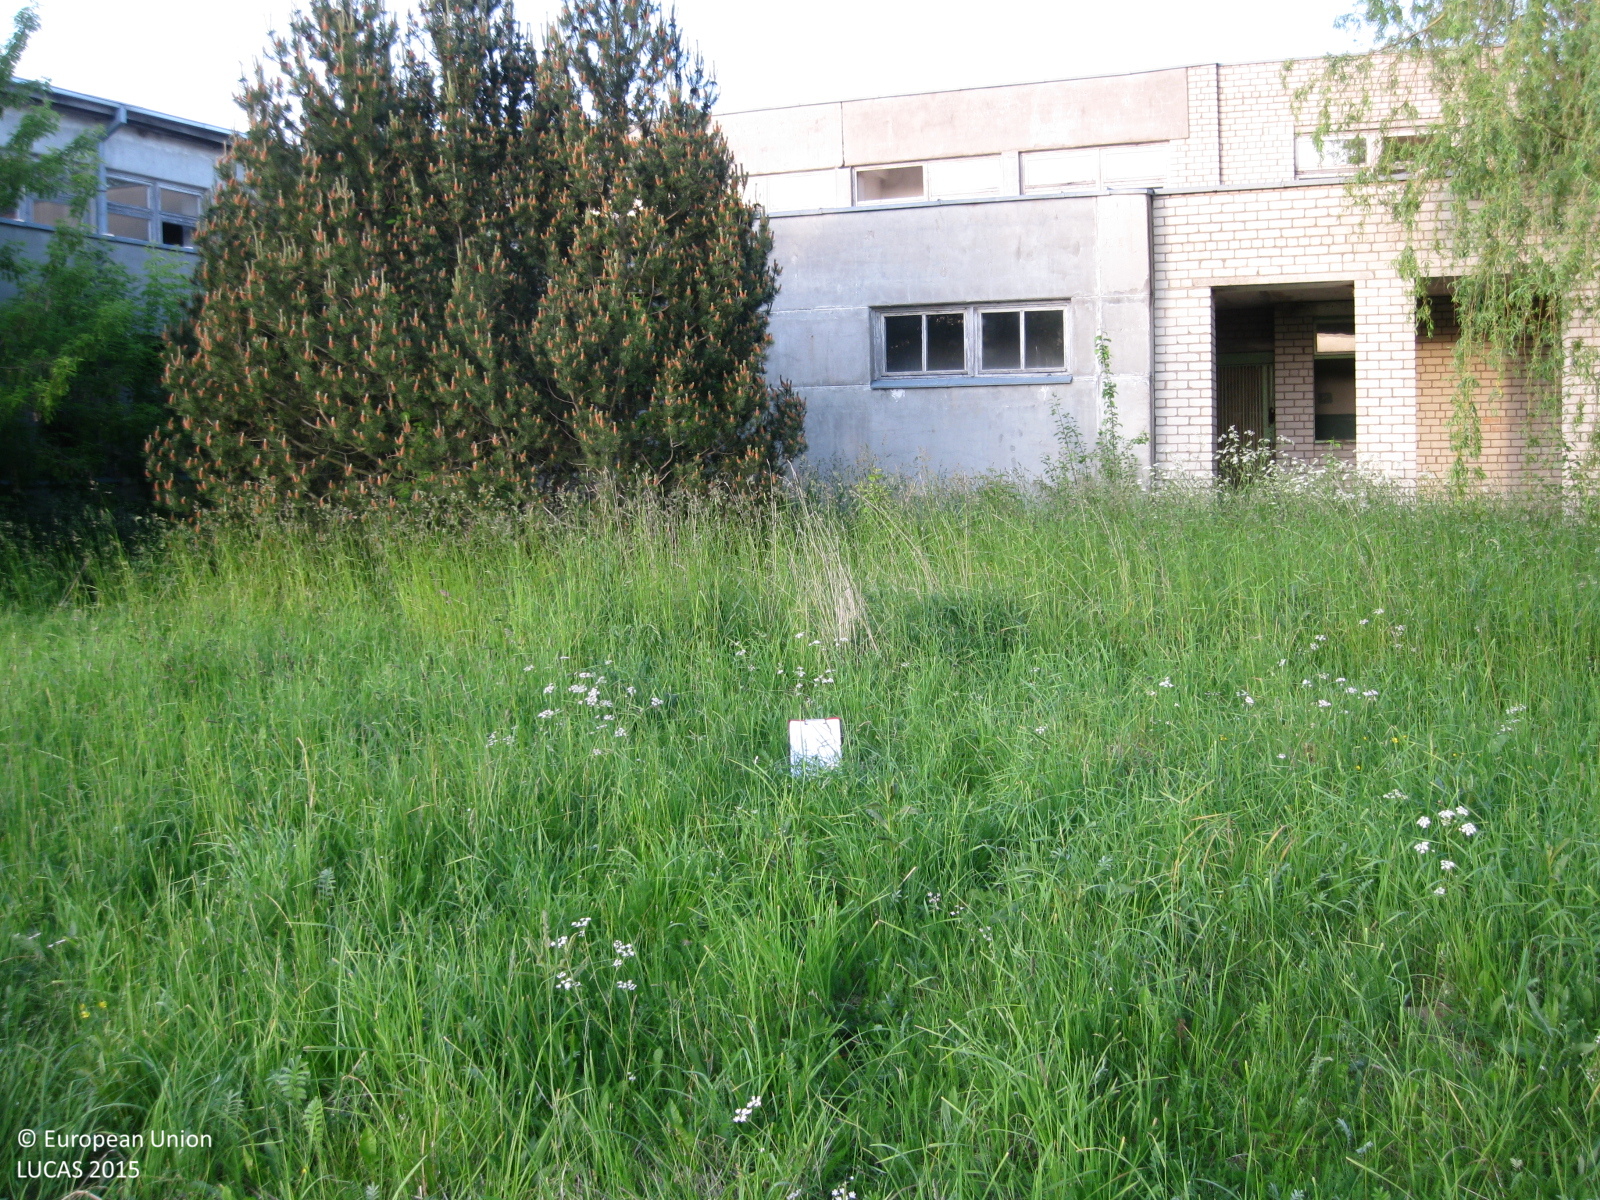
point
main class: Grassland
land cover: Grassland with sparse tree/shrub cover
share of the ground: > 75 %
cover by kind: herbaceous plants 90 %, coniferous forest trees 5 %, shrubs 5 %
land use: Abandoned areas
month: June
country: LT
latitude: 55.4521
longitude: 23.6645
